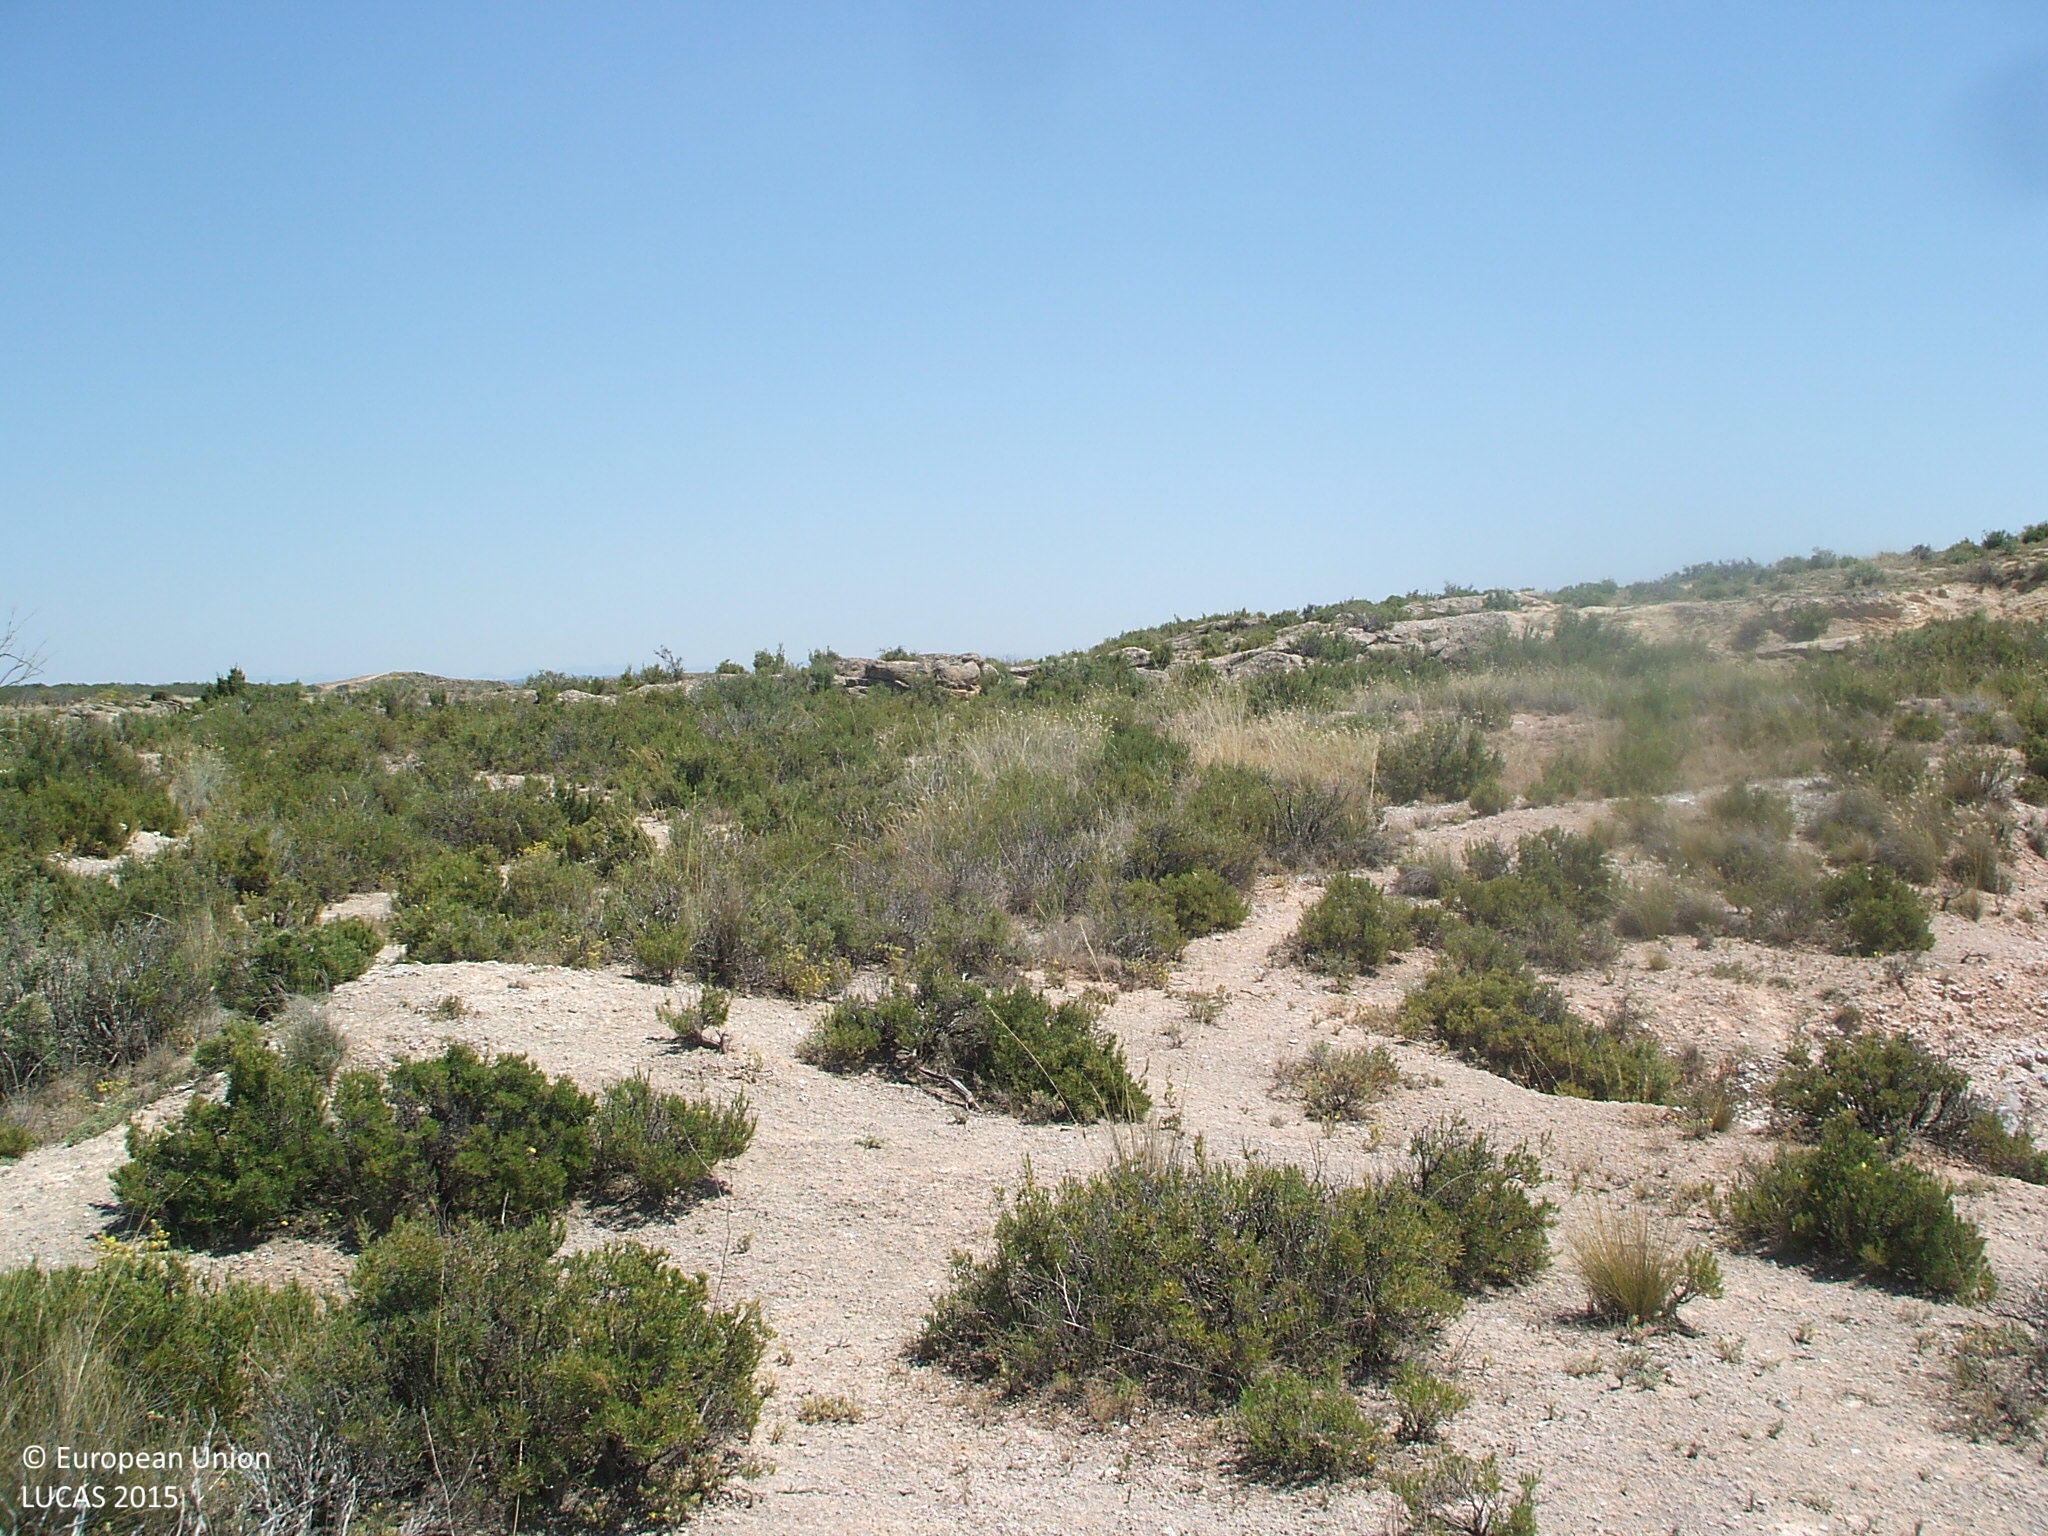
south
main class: Shrubland
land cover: Shrubland without tree cover
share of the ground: 10 - 25 %
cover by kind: consolidated bare surface 80 %, shrubs 20 %
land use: Semi-natural and natural areas not in use
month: June
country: ES
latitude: 41.0834
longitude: -0.1895
